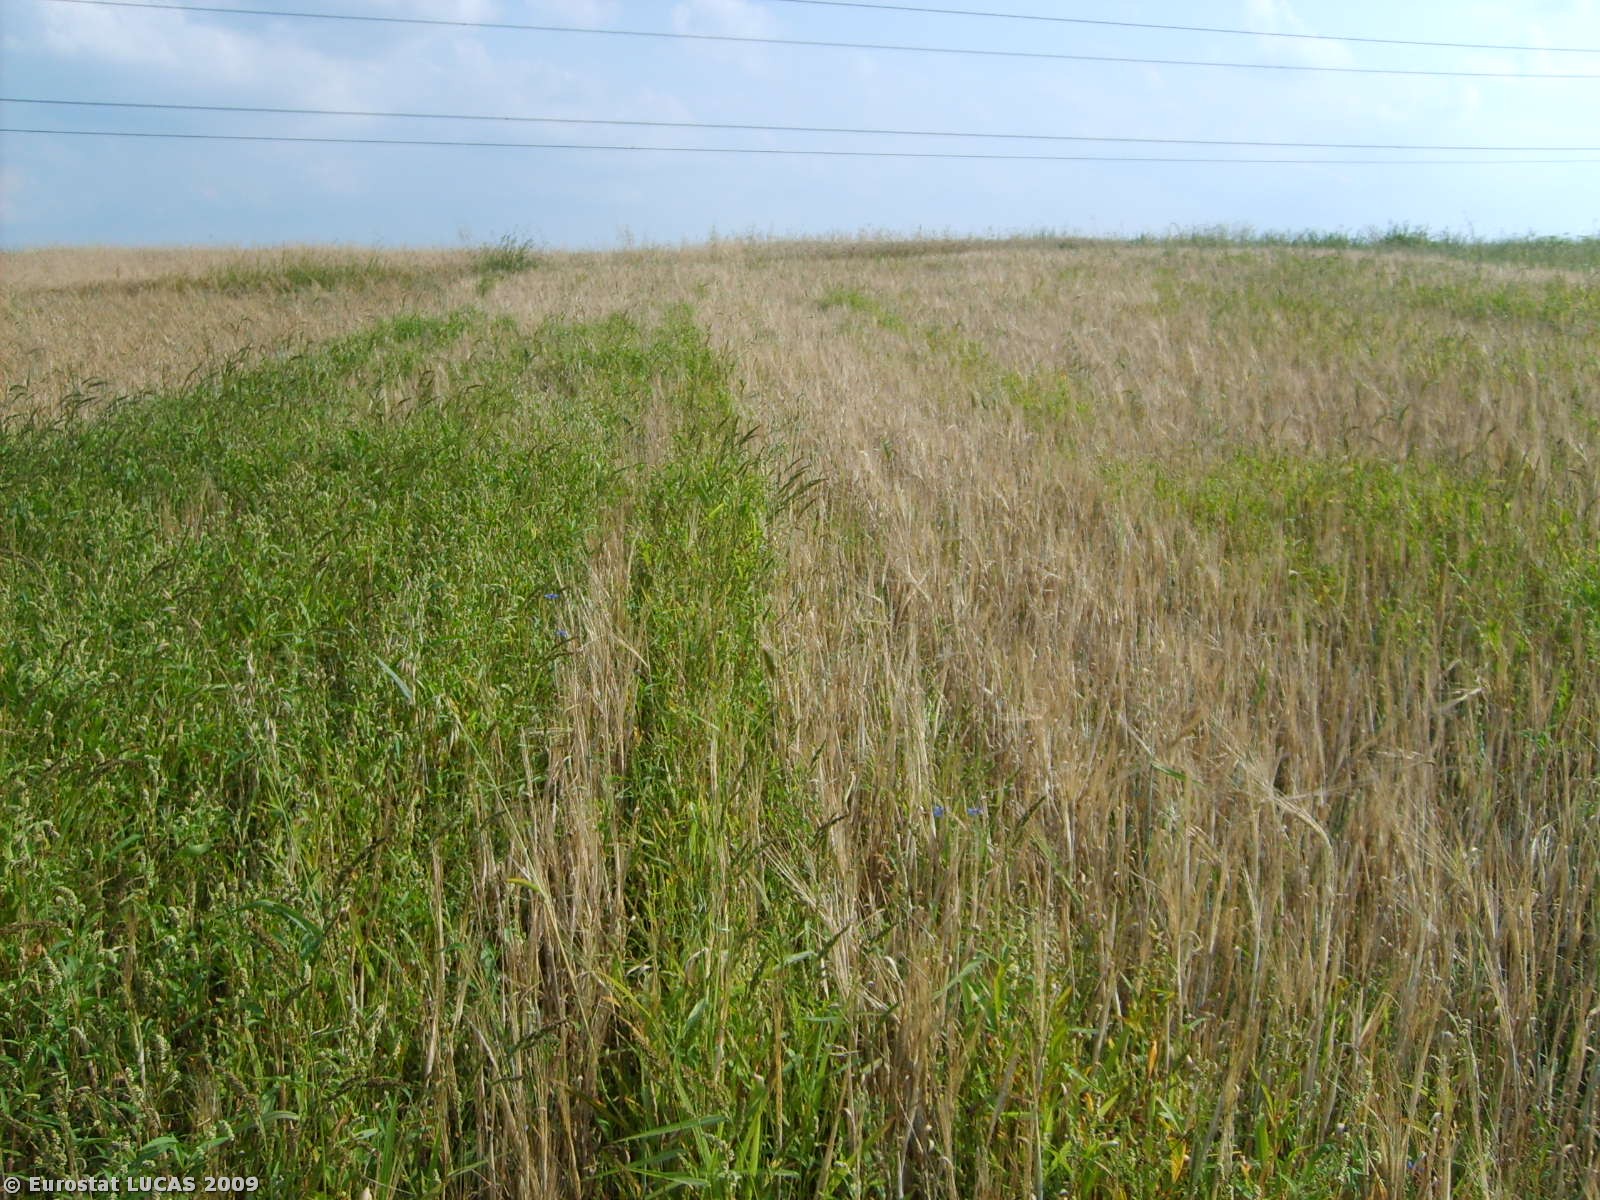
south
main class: Cropland
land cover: Barley
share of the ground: 25 - 50 %
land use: Agriculture (excluding fallow land and kitchen gardens)
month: July
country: PL
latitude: 49.9260
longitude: 20.1888
